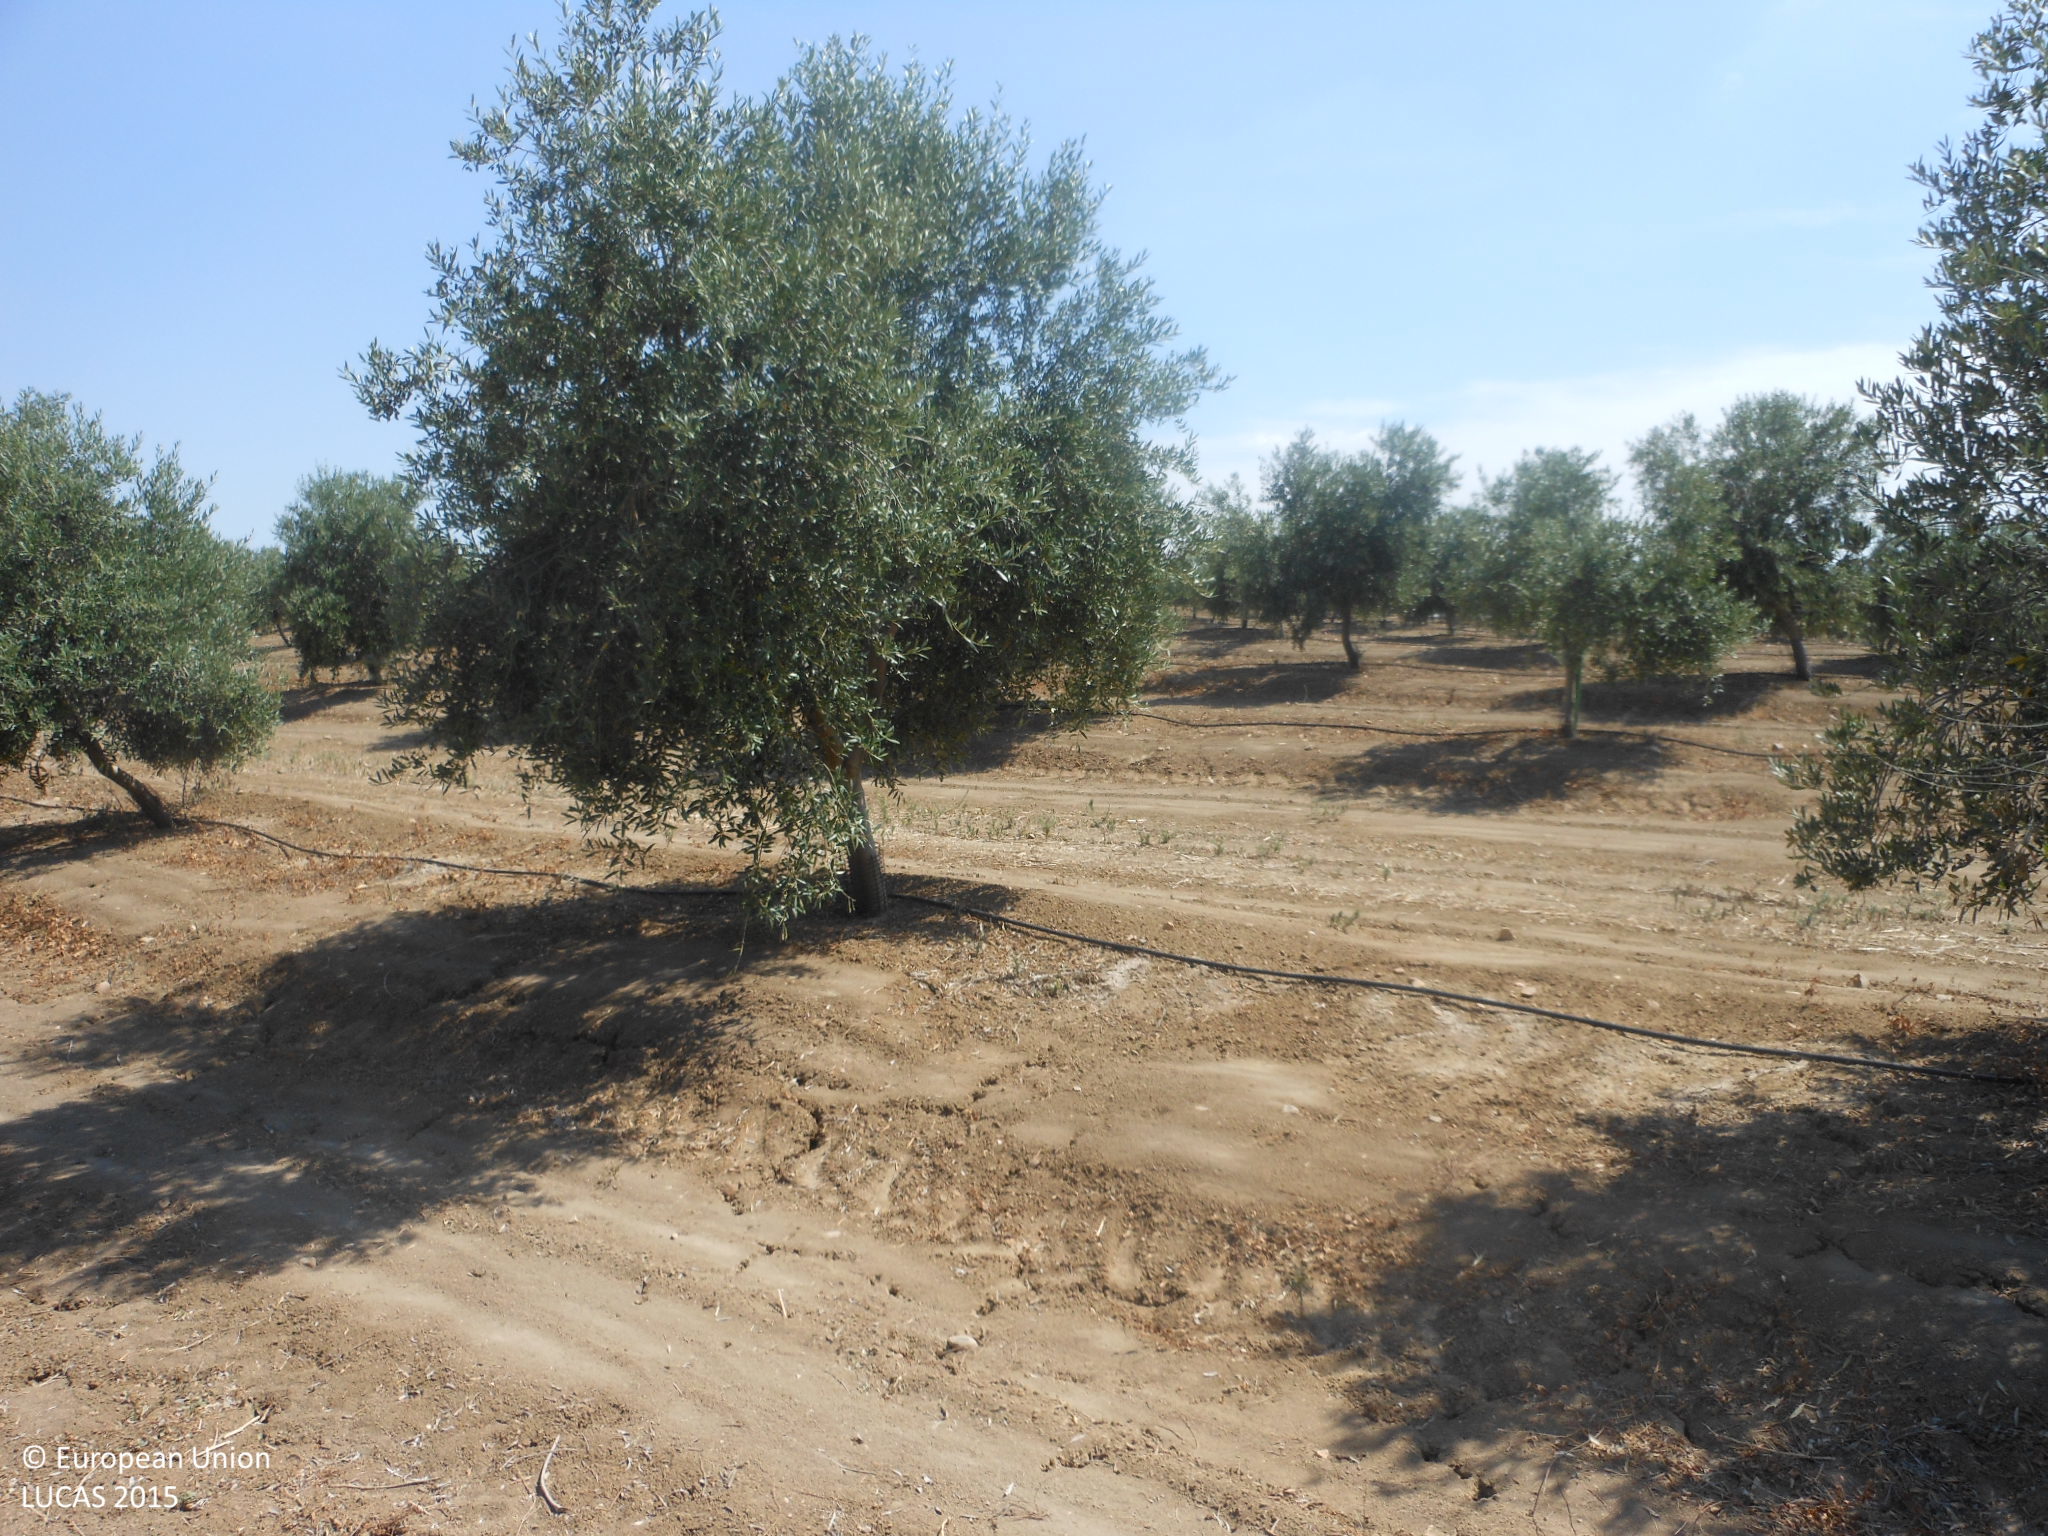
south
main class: Cropland
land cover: Olive groves
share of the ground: 50 - 75 %
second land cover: Other bare soil
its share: > 75 %
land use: Agriculture (excluding fallow land and kitchen gardens)
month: June
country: ES
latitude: 37.6424
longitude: -5.1910
